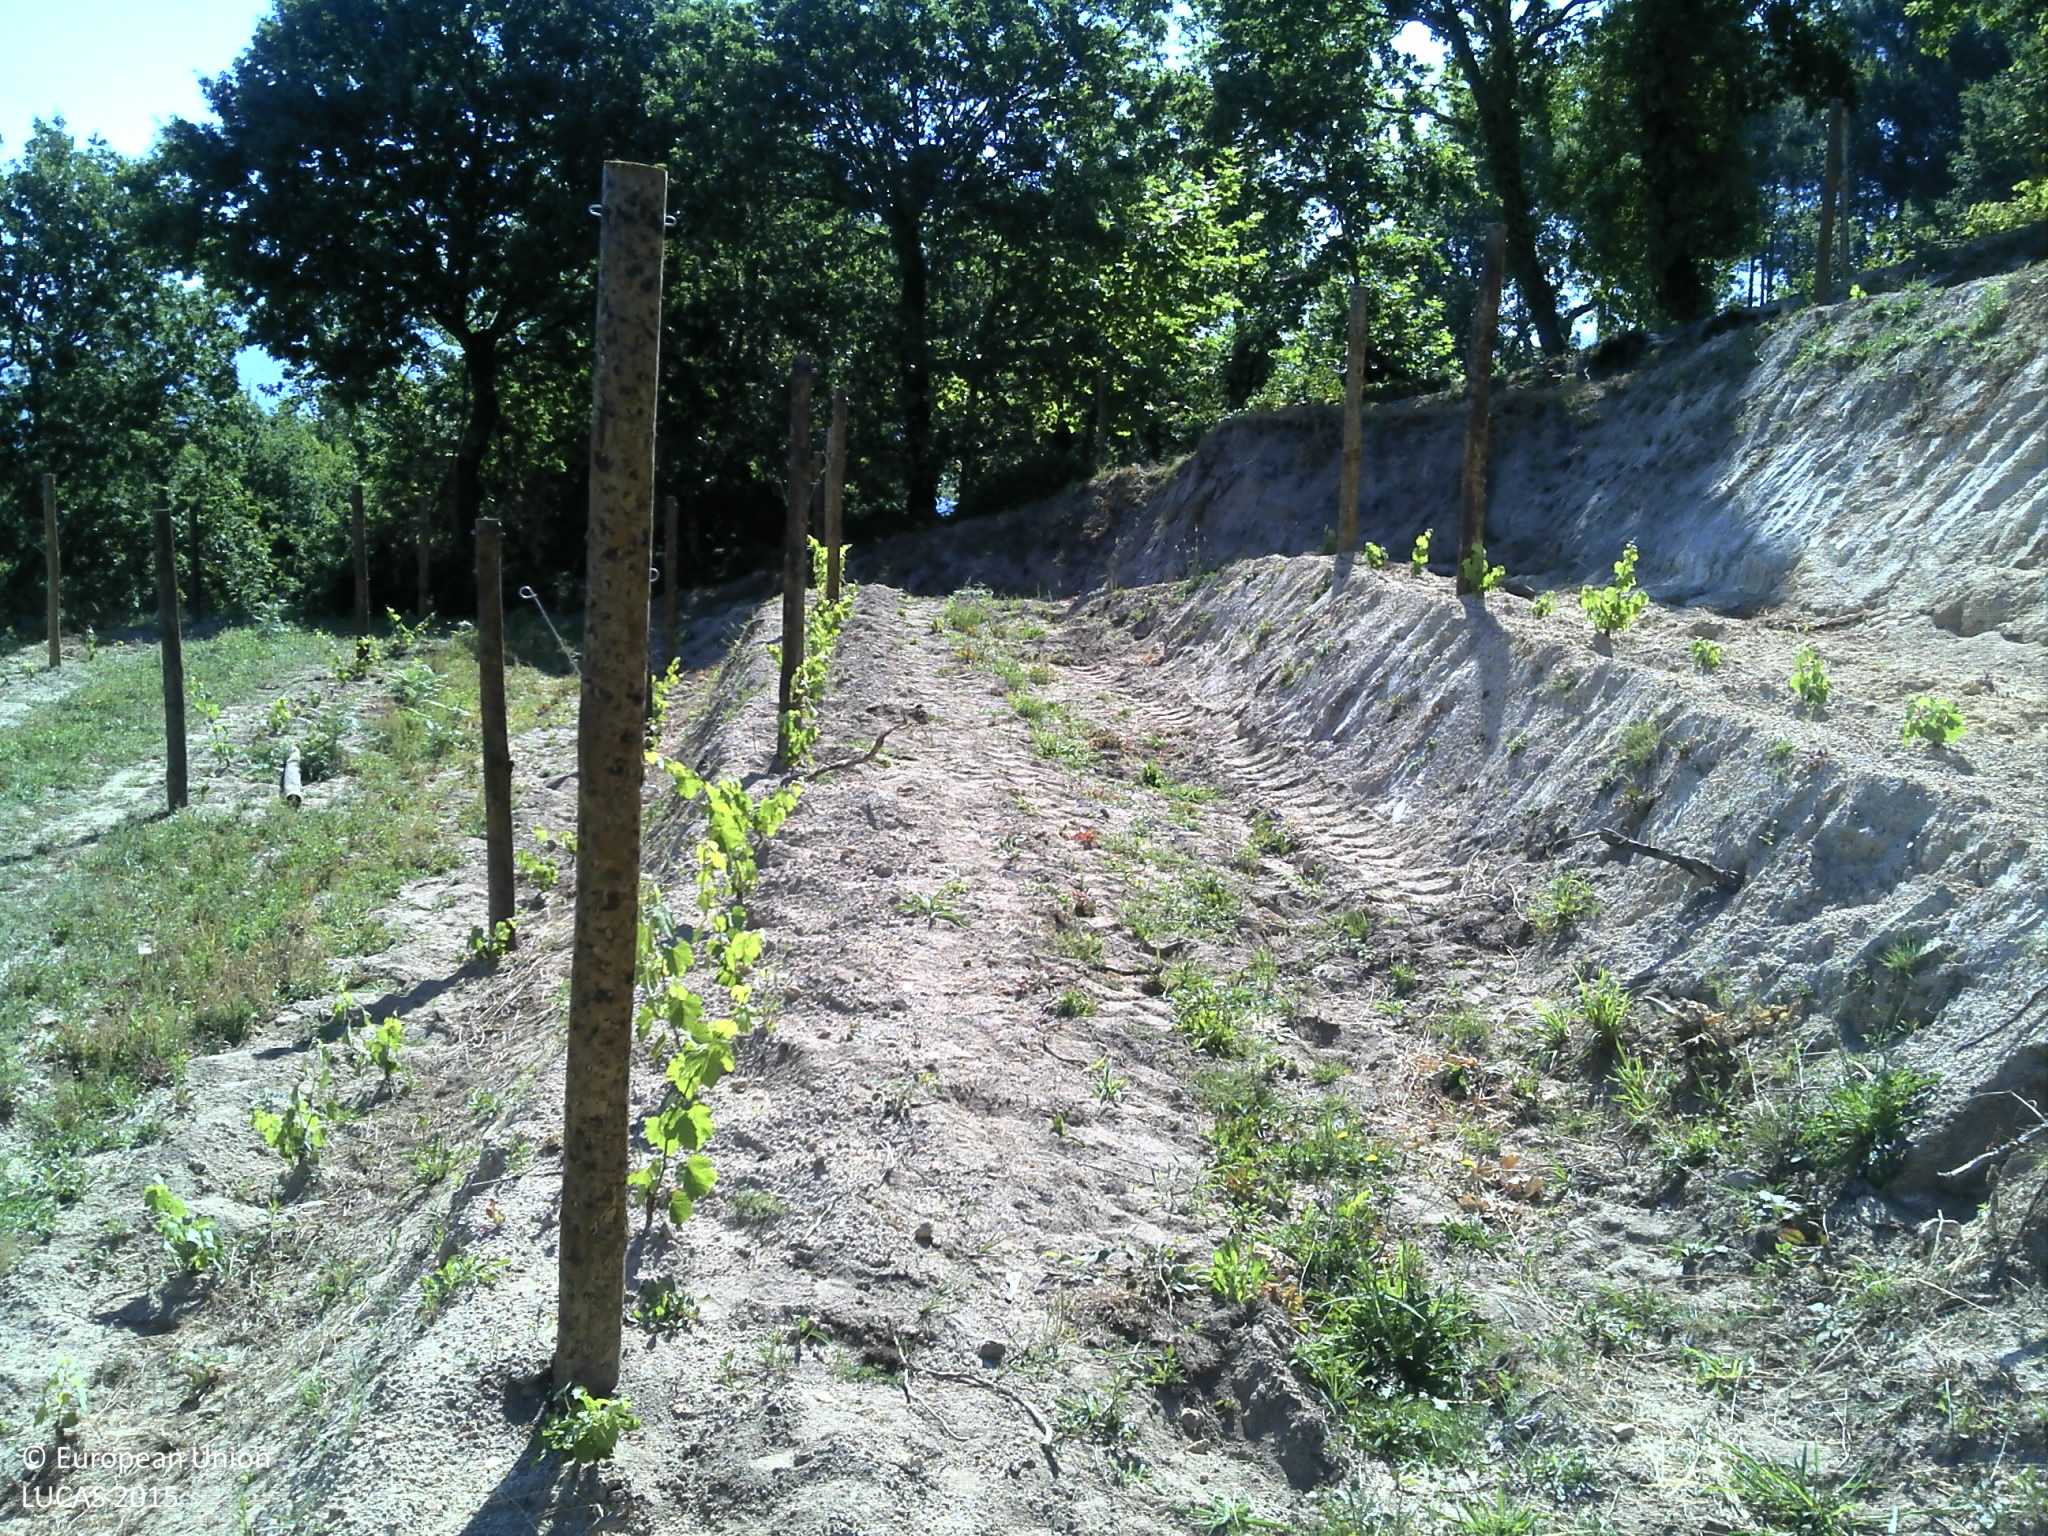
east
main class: Cropland
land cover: Vineyards
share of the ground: < 10 %
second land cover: Grassland without tree/shrub cover
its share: 25 - 50 %
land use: Agriculture (excluding fallow land and kitchen gardens)
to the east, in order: Vineyards; Grassland without tree/shrub cover; Vineyards; Dry stone walls; Broadleaved woodland; Grassland without tree/shrub cover; Dry stone walls; Broadleaved woodland; Fences; Grassland without tree/shrub cover; Electric lines; Grassland without tree/shrub cover; Other fresh vegetables; Fences; Shruby margins; Dry stone walls; Paved roads, cycling and walking lanes; Electric lines; Dry stone walls; Shruby margins; Grassland without tree/shrub cover; Broadleaved woodland
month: July
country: PT
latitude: 41.4605
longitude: -7.8427
